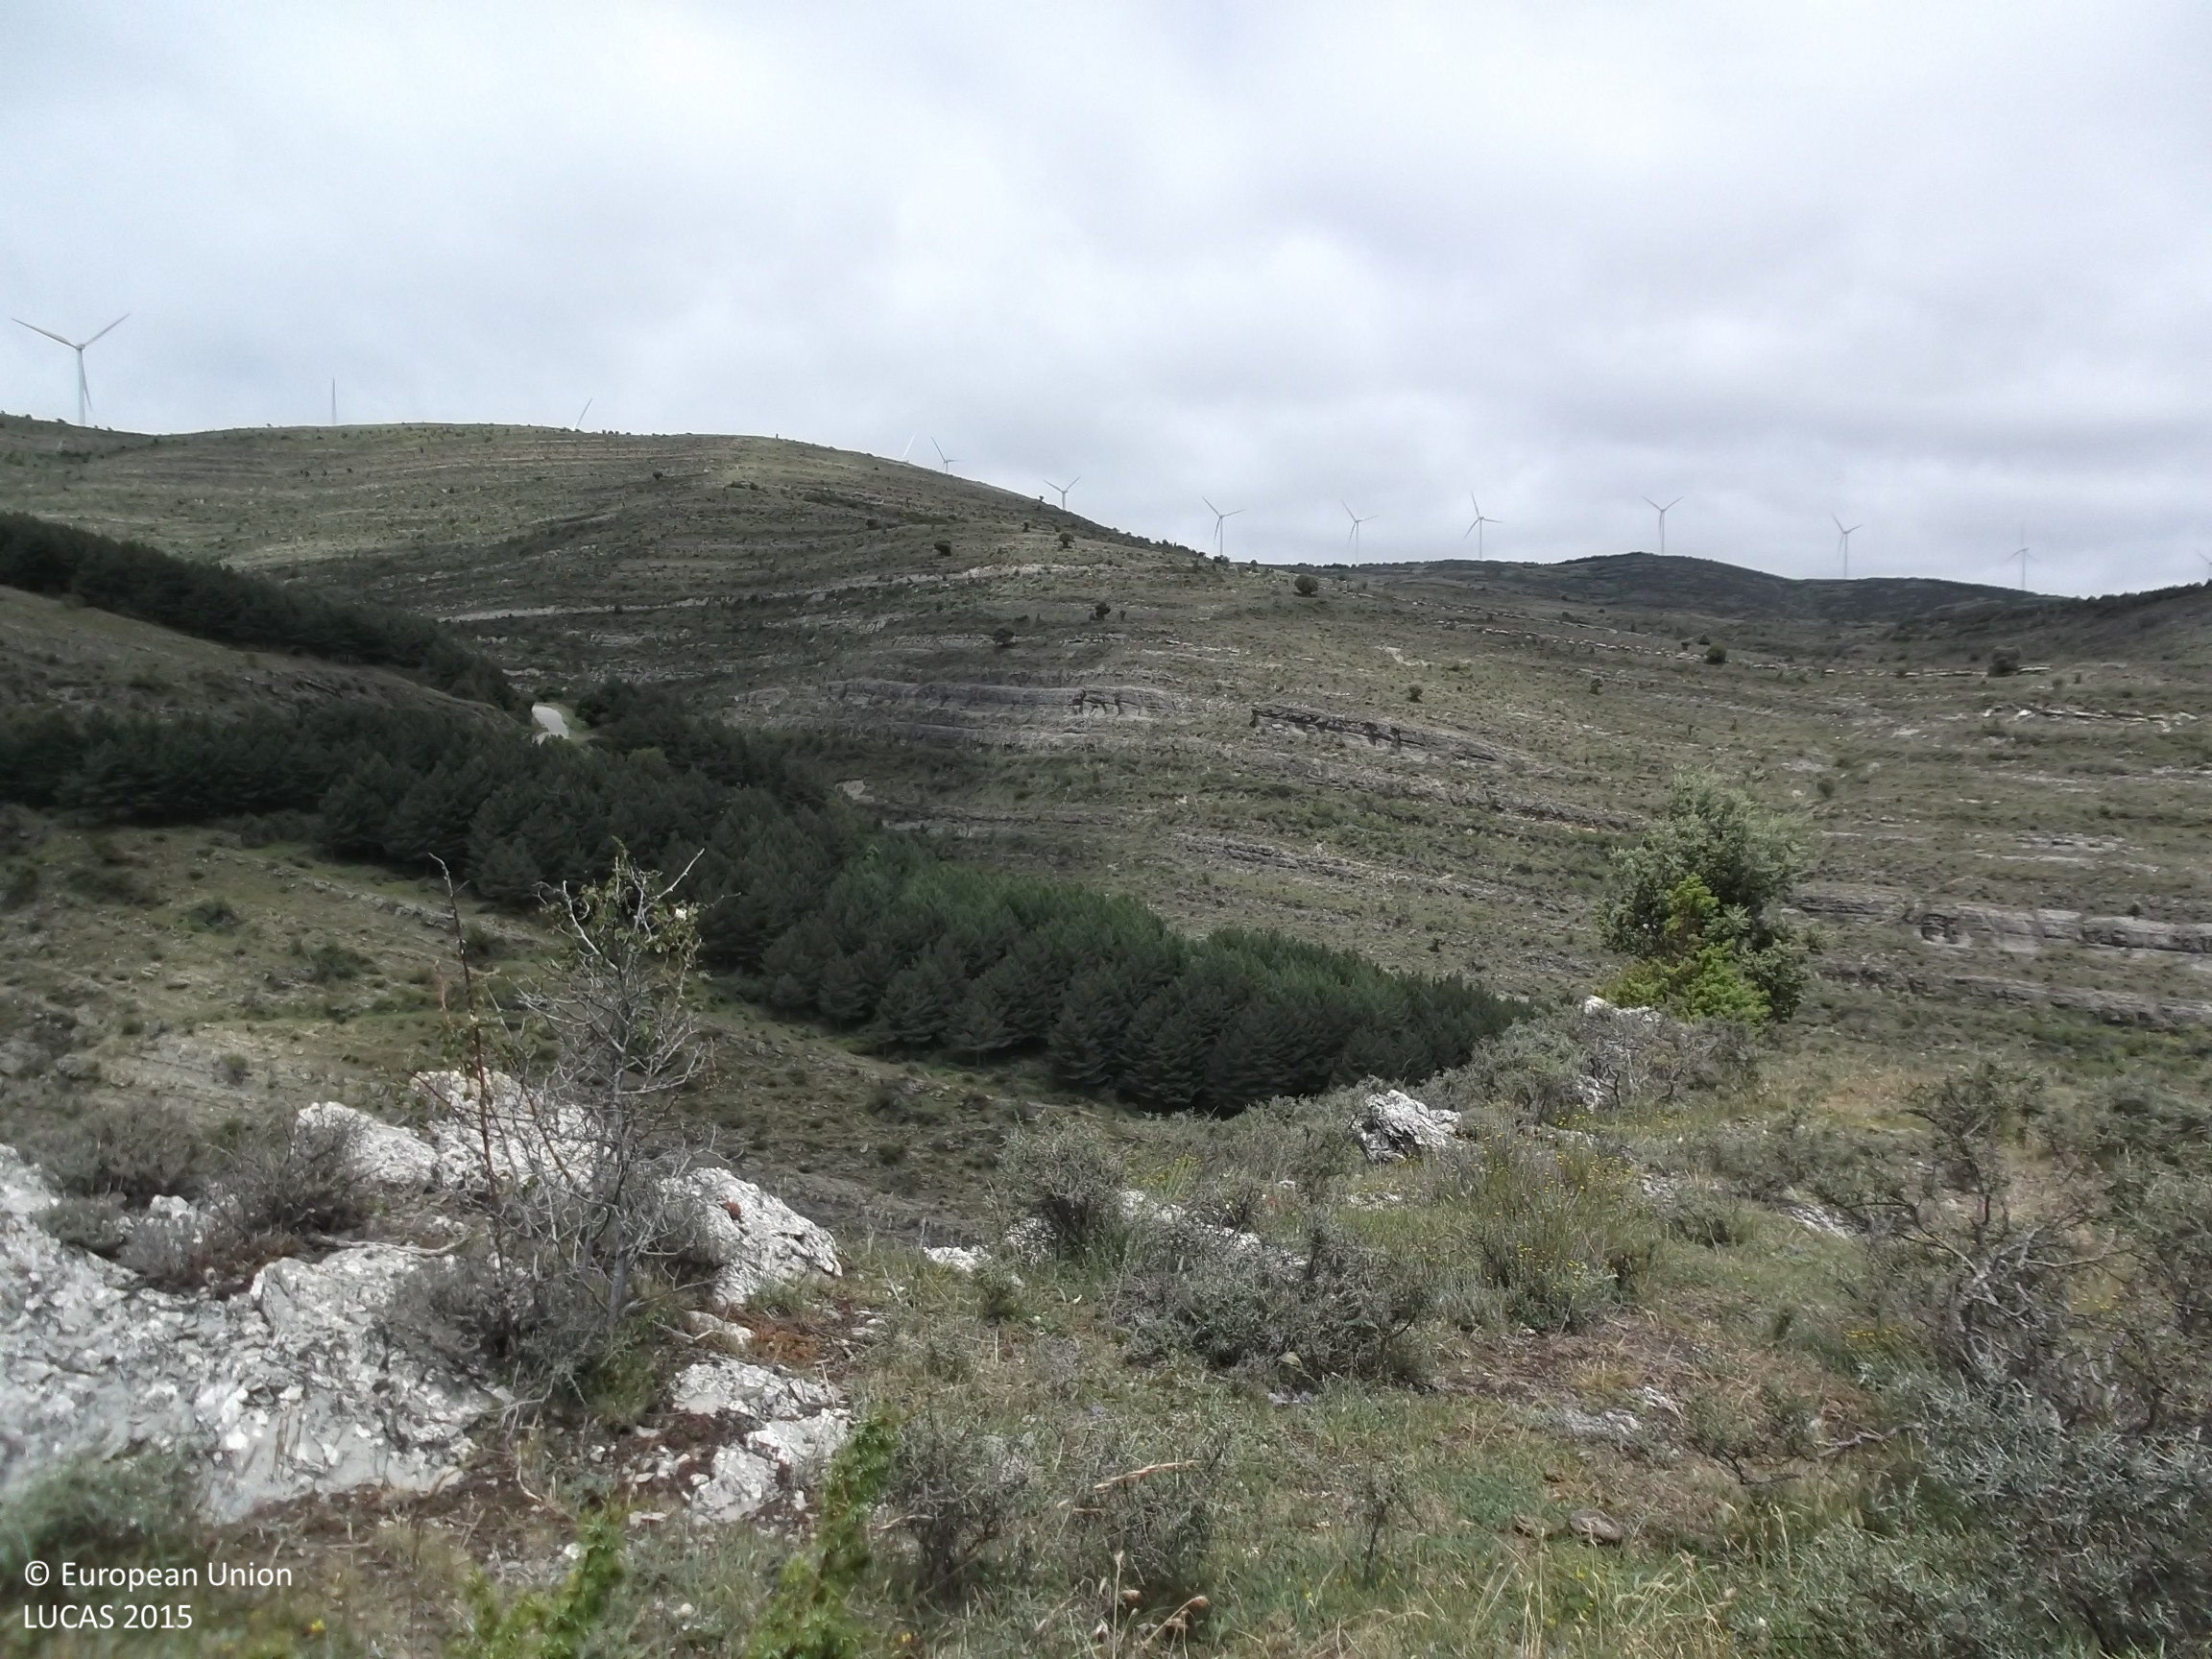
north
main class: Shrubland
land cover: Shrubland with sparse tree cover
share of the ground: 50 - 75 %
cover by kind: shrubs 50 %, herbaceous plants 30 %, unconsolidated bare surface 15 %, broadleaved forest trees 5 %
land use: Agriculture (excluding fallow land and kitchen gardens)
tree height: < 5 m
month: June
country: ES
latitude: 42.1835
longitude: -2.3789
